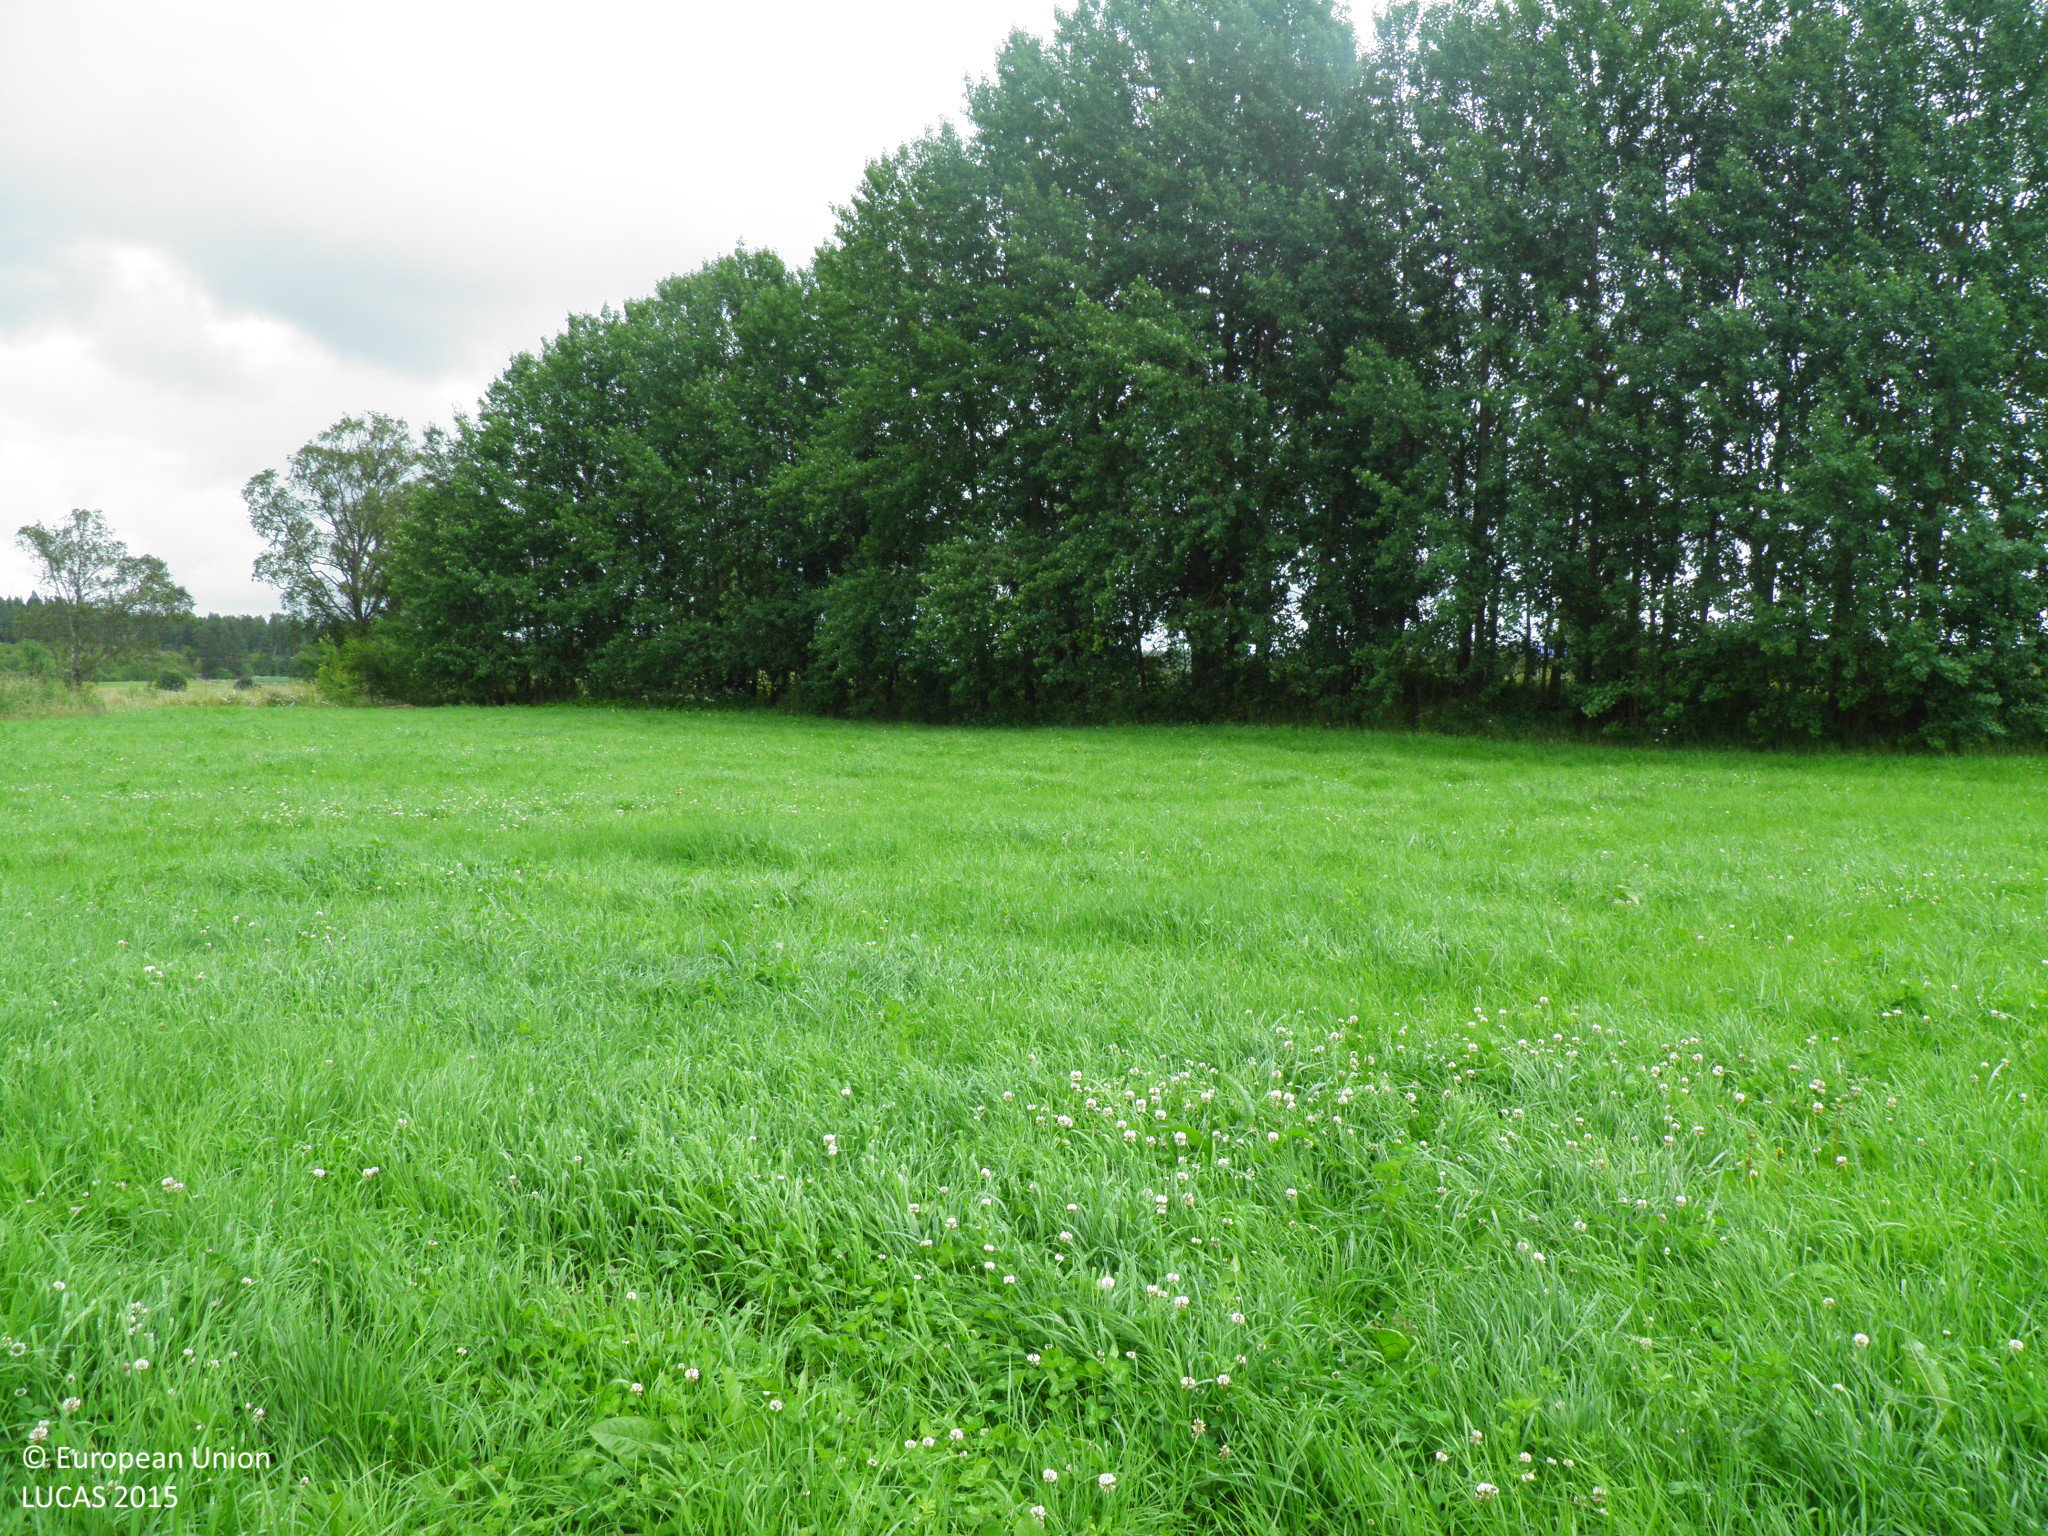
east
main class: Cropland
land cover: Temporary grasslands
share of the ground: > 75 %
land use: Agriculture (excluding fallow land and kitchen gardens)
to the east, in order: Temporary grasslands; Broadleaved woodland; Ditches and canals; Paved roads, cycling and walking lanes; Grassland with sparse tree/shrub cover; Electric lines; Grassland with sparse tree/shrub cover; Ditches and canals; Grass margins; Common wheat
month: July
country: FI
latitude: 60.6512
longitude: 21.5614
